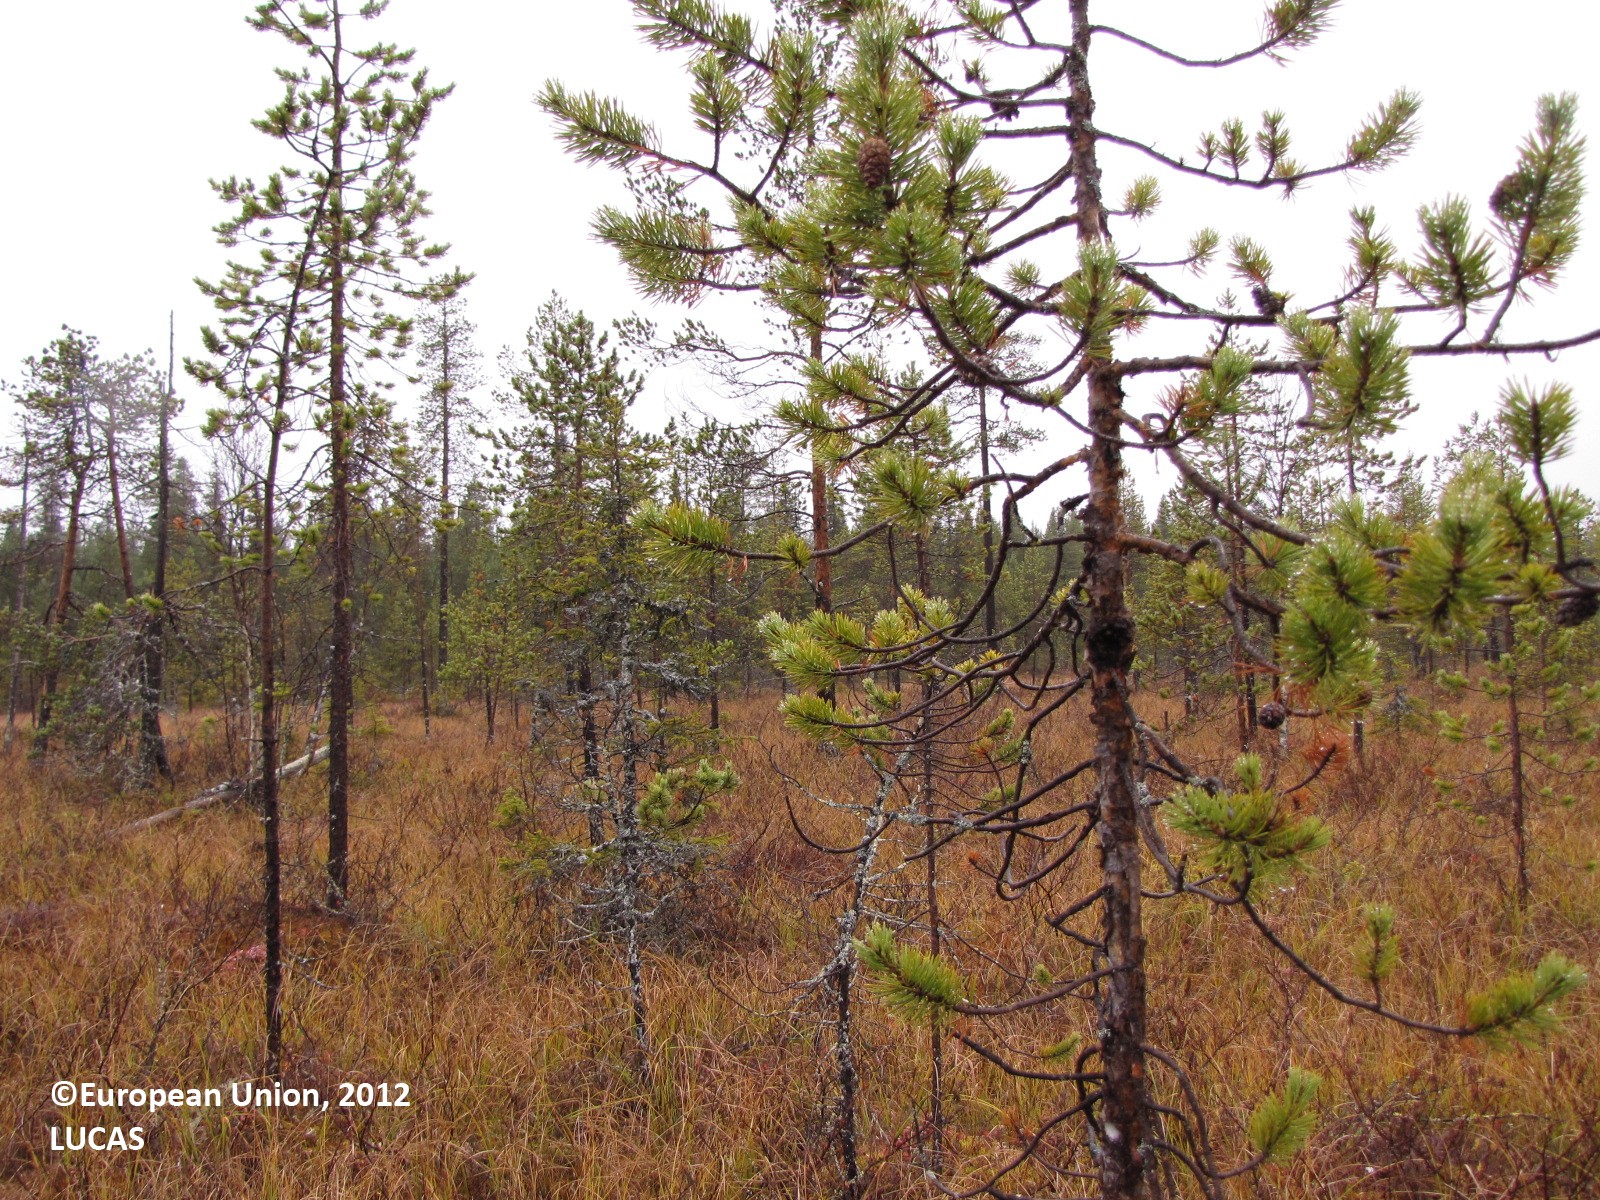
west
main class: Woodland
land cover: Pine dominated coniferous woodland
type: boreal forest
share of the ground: 10 - 25 %
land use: Forestry
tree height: < 5 m
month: September
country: FI
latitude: 67.7147
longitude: 23.6017
